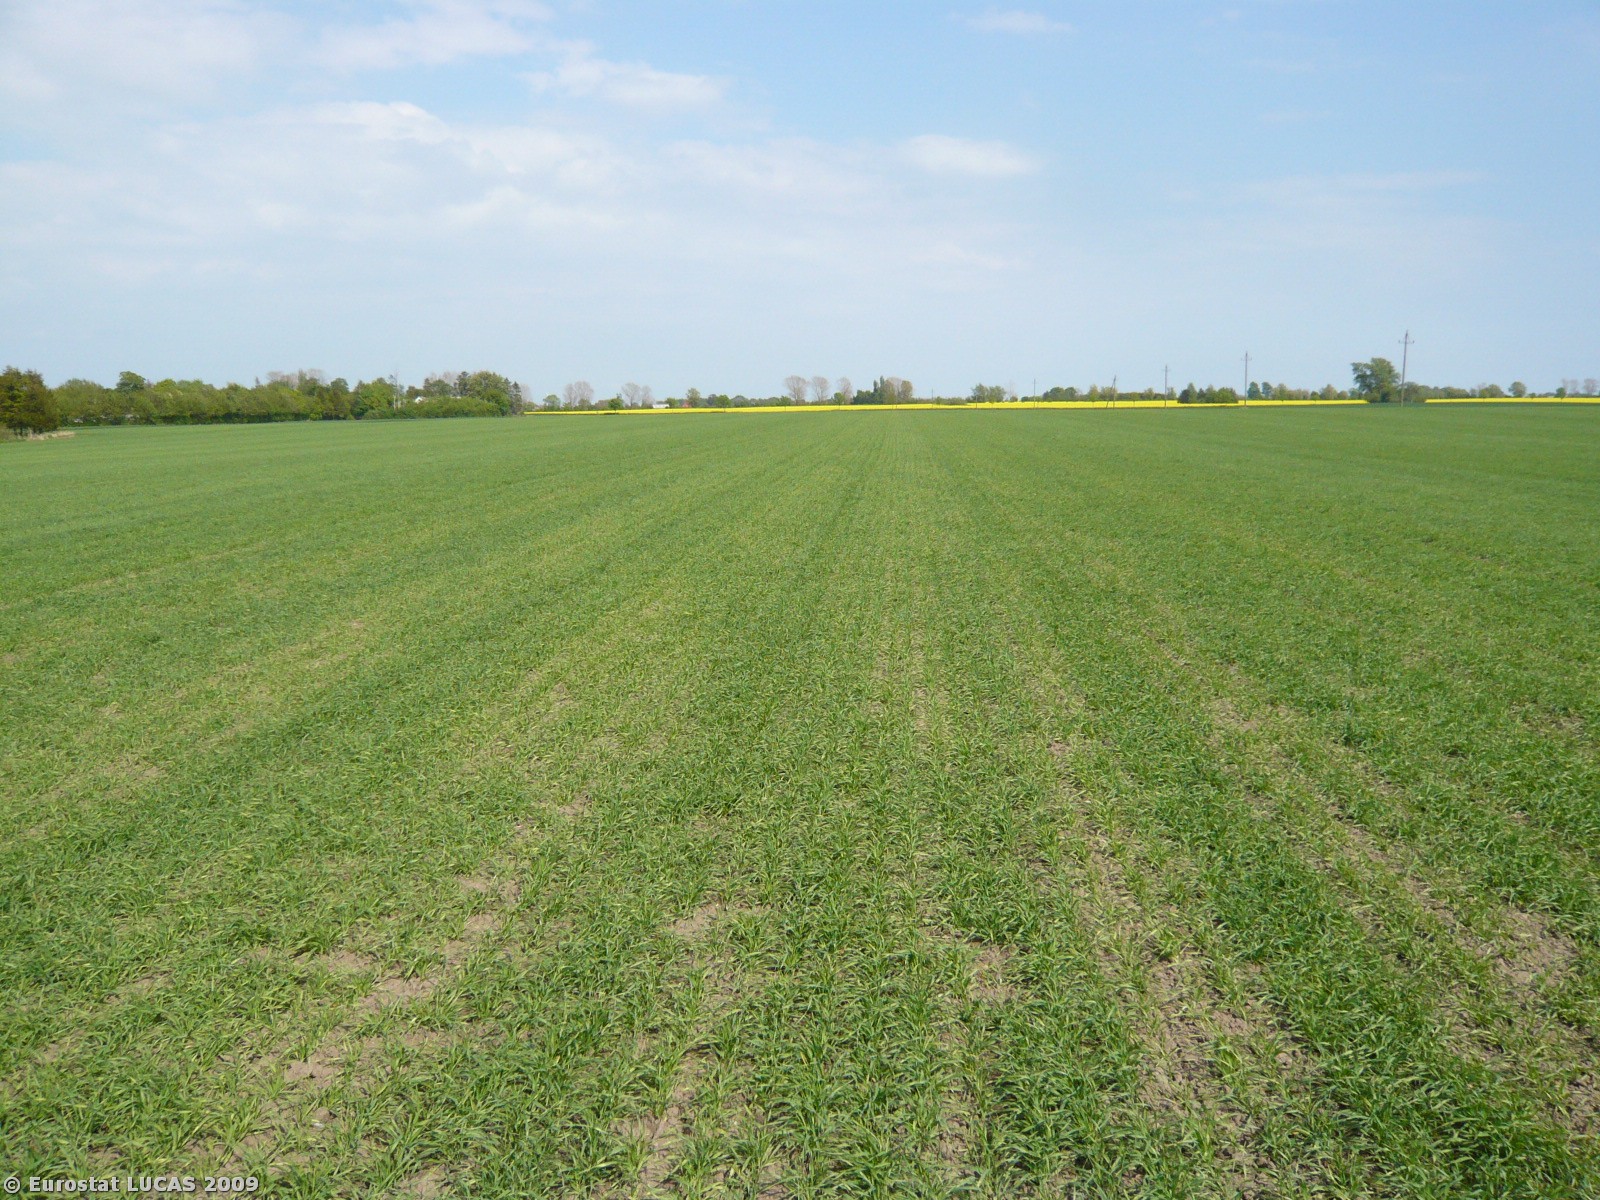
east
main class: Cropland
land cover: Barley
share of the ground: > 75 %
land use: Agriculture (excluding fallow land and kitchen gardens)
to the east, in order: Barley
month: May
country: DK
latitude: 55.2684
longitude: 12.2805
